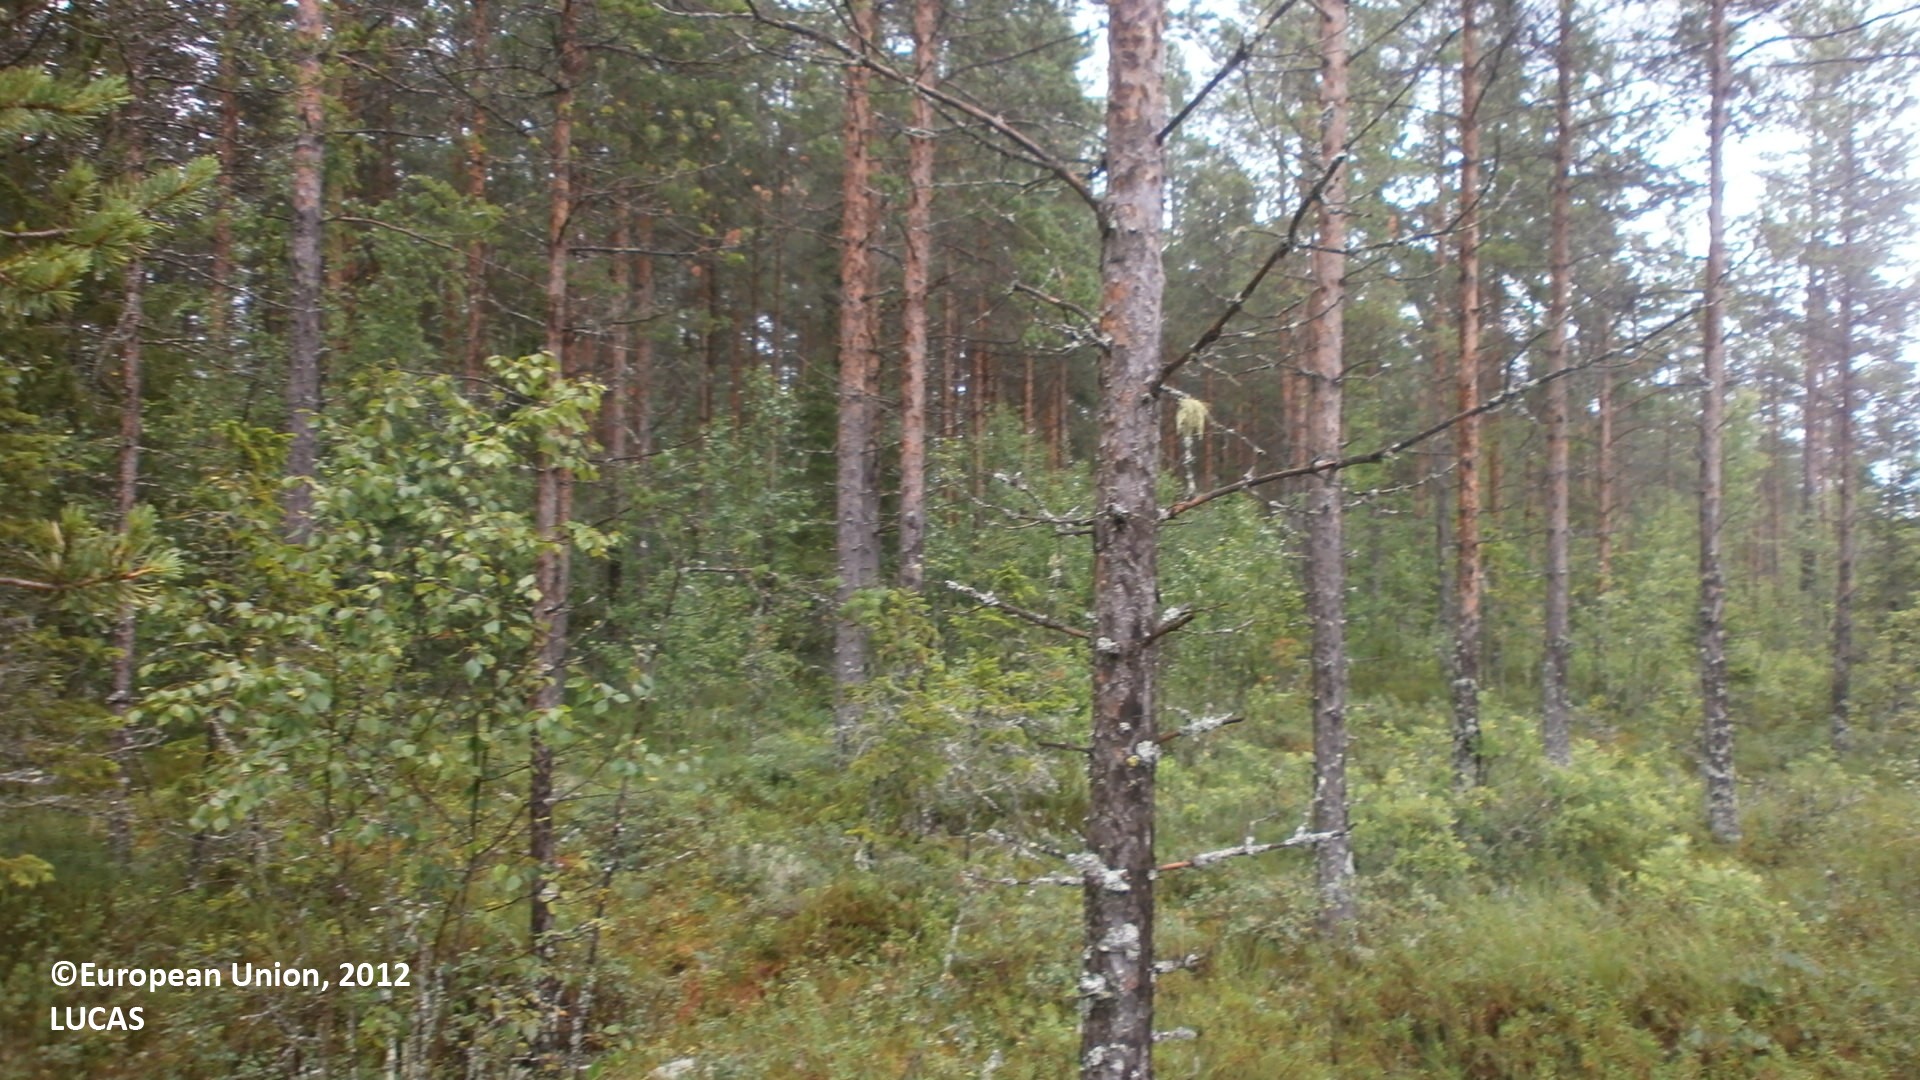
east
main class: Woodland
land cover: Pine dominated coniferous woodland
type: mire and swamp forests
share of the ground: 50 - 75 %
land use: Forestry
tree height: > 5 m
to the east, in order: Pine dominated coniferous woodland; Ditches and canals; Pine dominated coniferous woodland; Ditches and canals; Pine dominated coniferous woodland; Ditches and canals; Pine dominated coniferous woodland
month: July
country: FI
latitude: 64.0733
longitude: 23.7333
